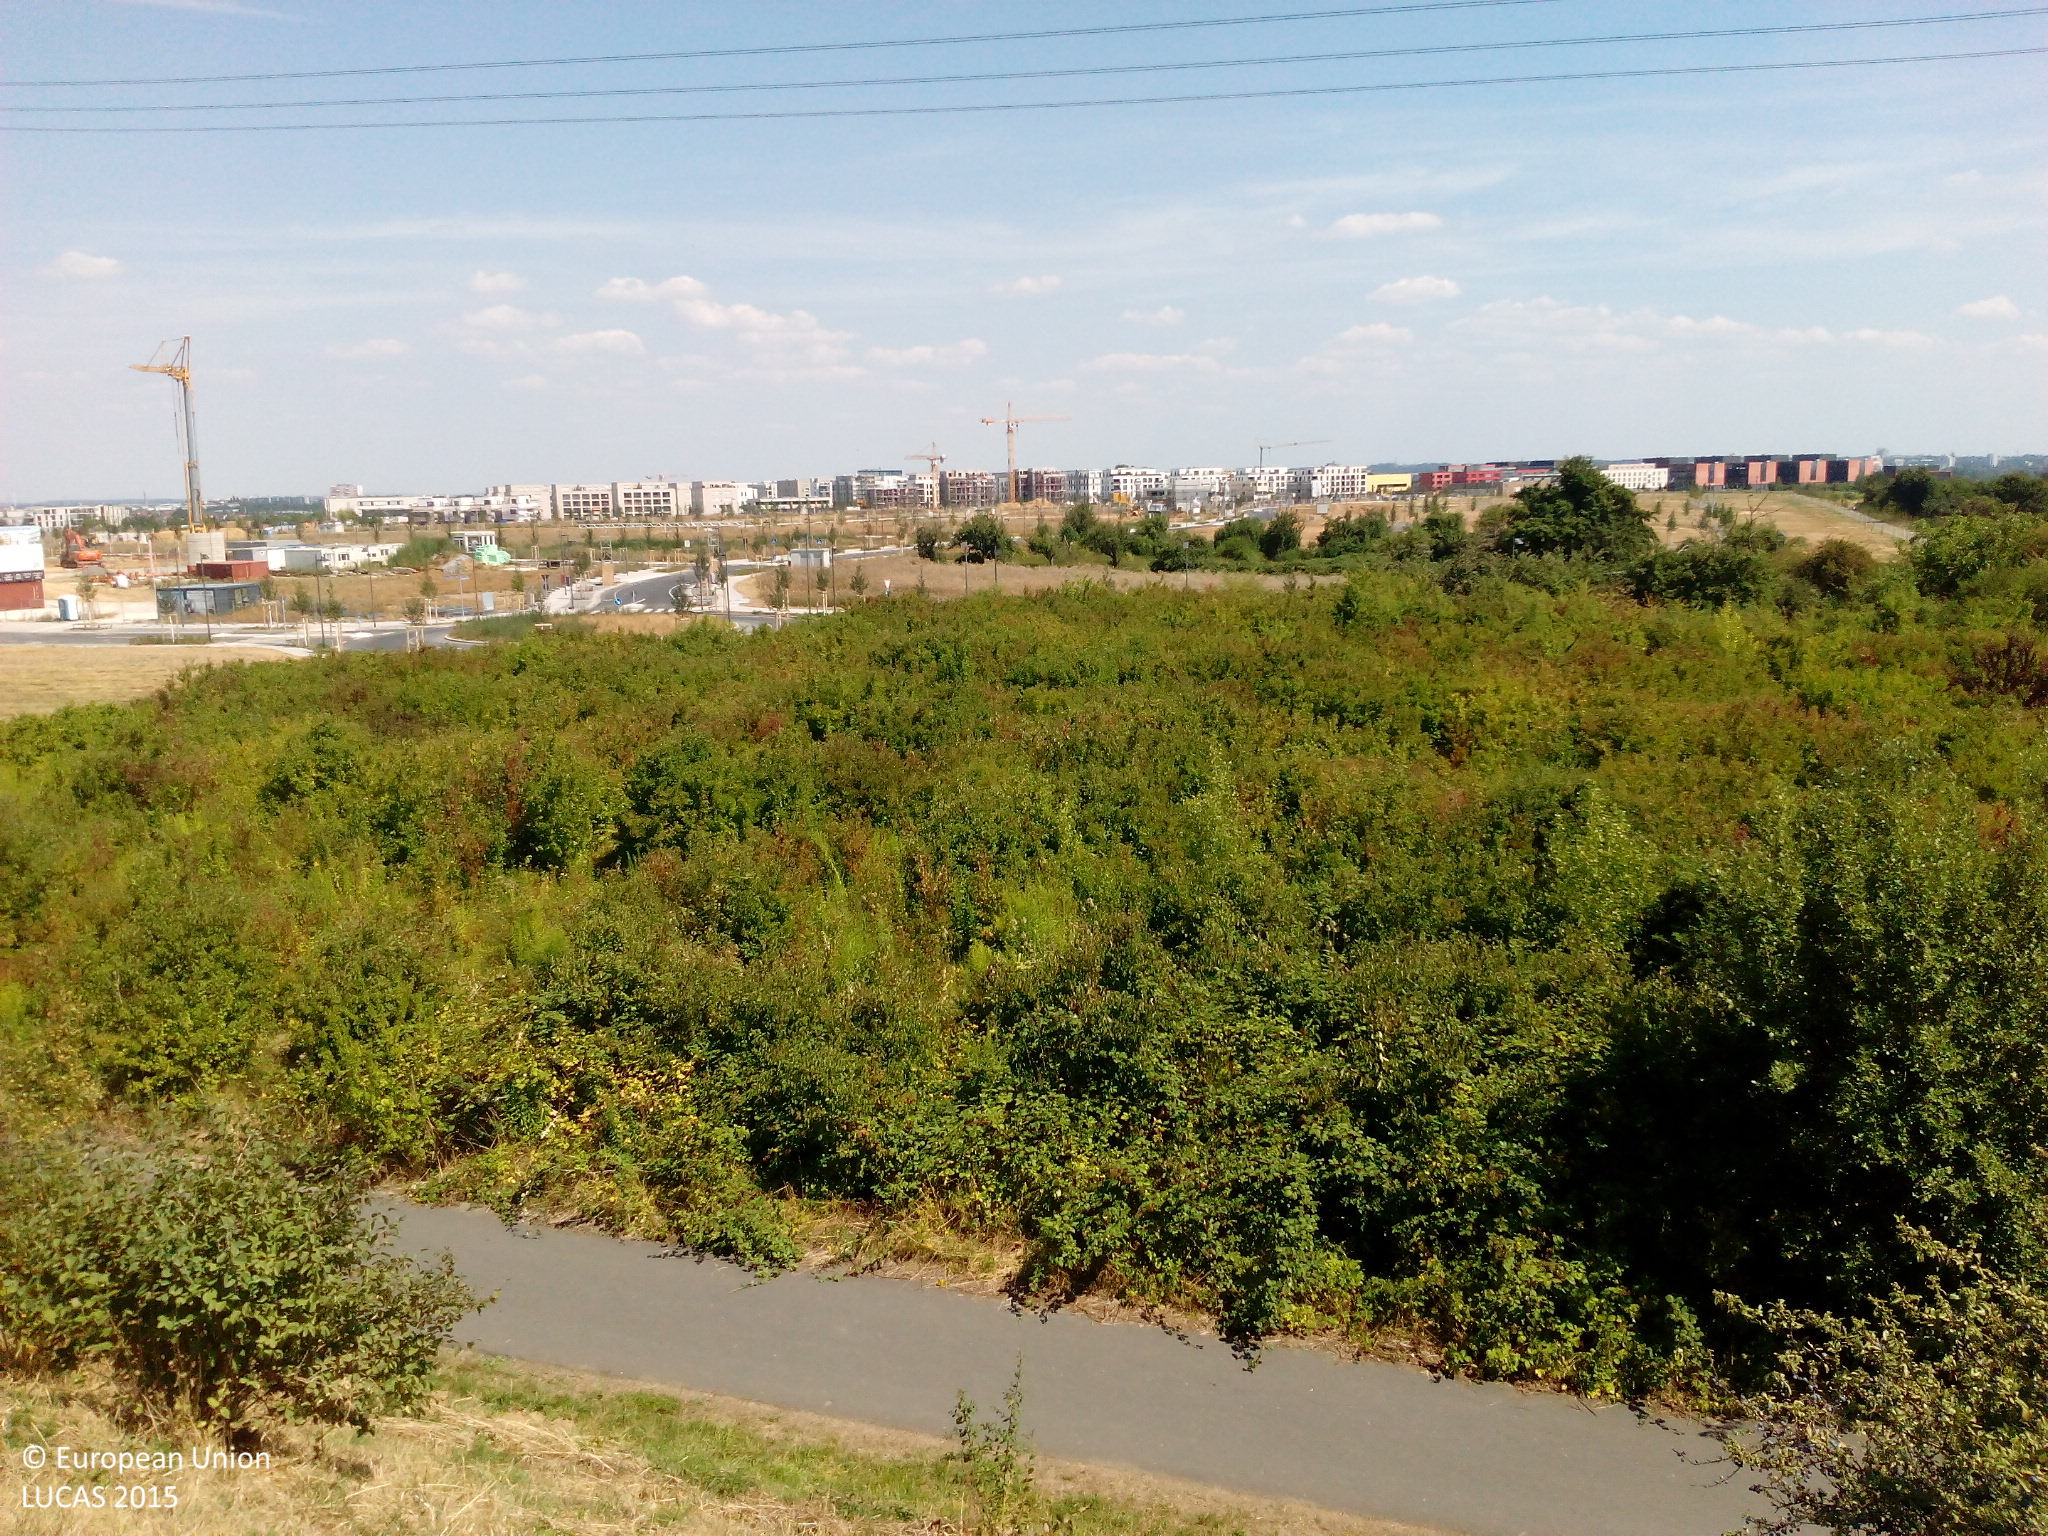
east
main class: Shrubland
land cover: Shrubland without tree cover
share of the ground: > 75 %
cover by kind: herbaceous plants 80 %, shrubs 15 %, unconsolidated bare surface 5 %
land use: Road transport
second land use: Protection infrastructures
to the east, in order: Shrubland without tree cover; Grass margins; Paved roads, cycling and walking lanes; Shrubland with sparse tree cover; Electric lines; Broadleaved woodland; Shruby margins; Grassland without tree/shrub cover; Paved roads, cycling and walking lanes; Lines of trees; Paved roads, cycling and walking lanes; Lines of trees; Paved roads, cycling and walking lanes; Spontaneously vegetated surfaces; Apple fruit; Grassland with sparse tree/shrub cover; Spontaneously vegetated surfaces; Grassland with sparse tree/shrub cover
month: August
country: DE
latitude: 50.1758
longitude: 8.6141
